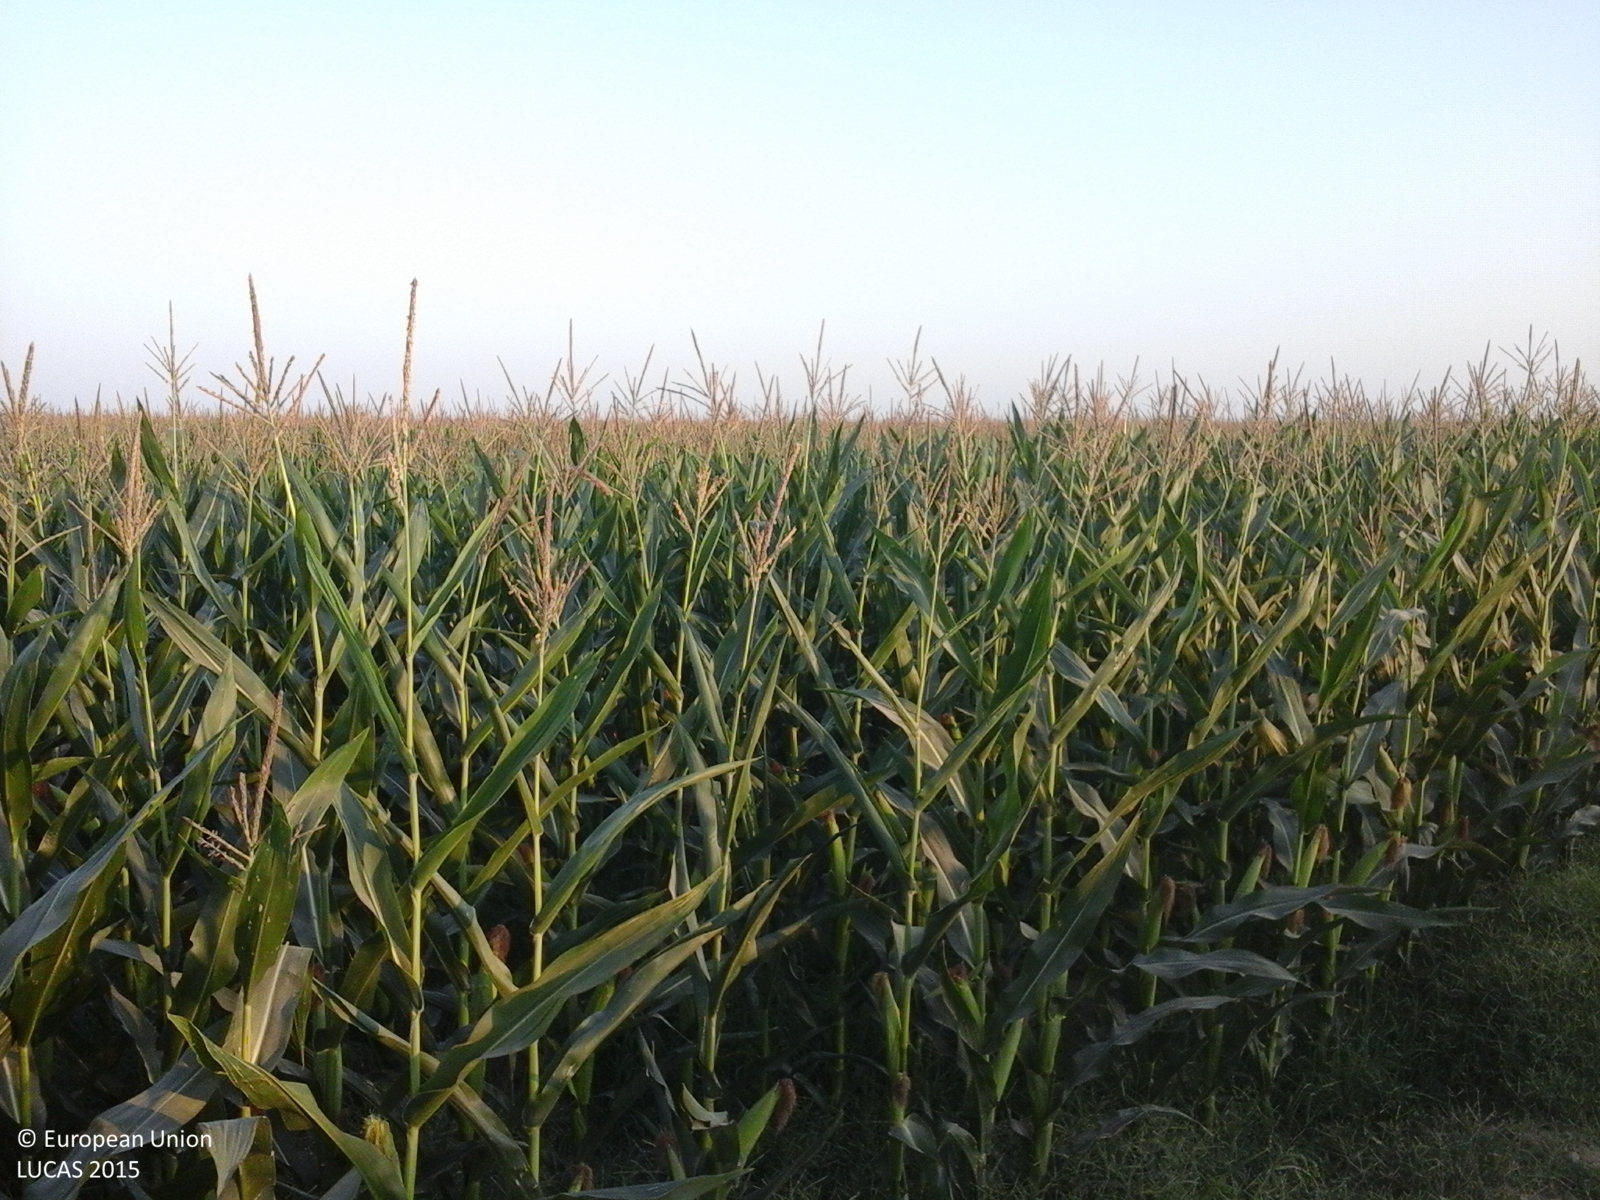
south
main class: Cropland
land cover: Maize
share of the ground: > 75 %
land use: Agriculture (excluding fallow land and kitchen gardens)
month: July
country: RO
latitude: 45.0968
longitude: 26.9453
